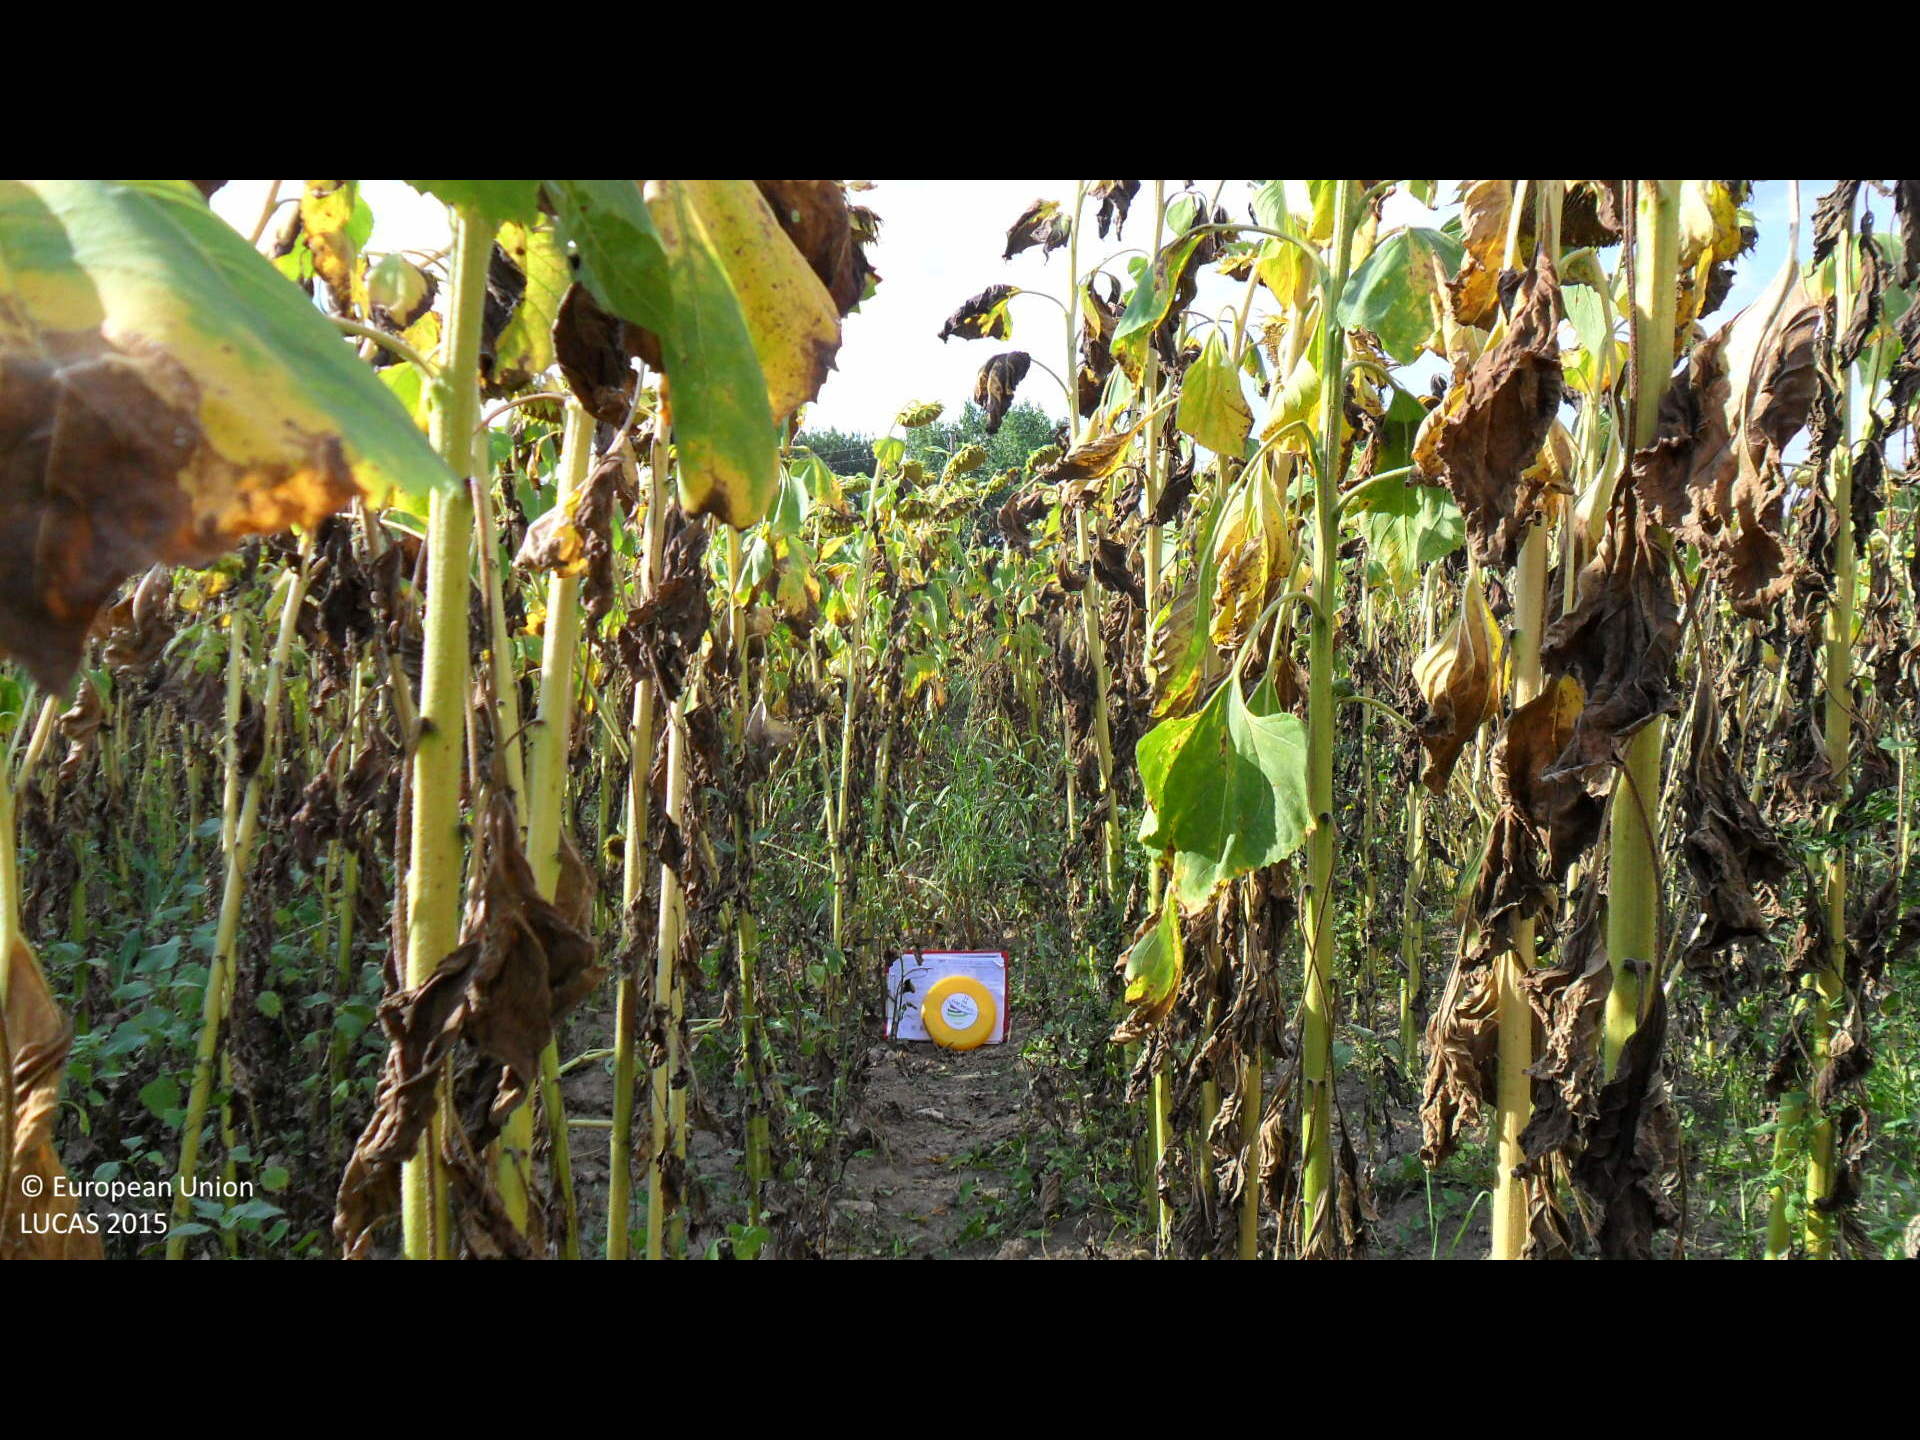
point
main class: Cropland
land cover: Sunflower
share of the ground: > 75 %
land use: Agriculture (excluding fallow land and kitchen gardens)
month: August
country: BG
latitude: 43.3555
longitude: 26.1210
